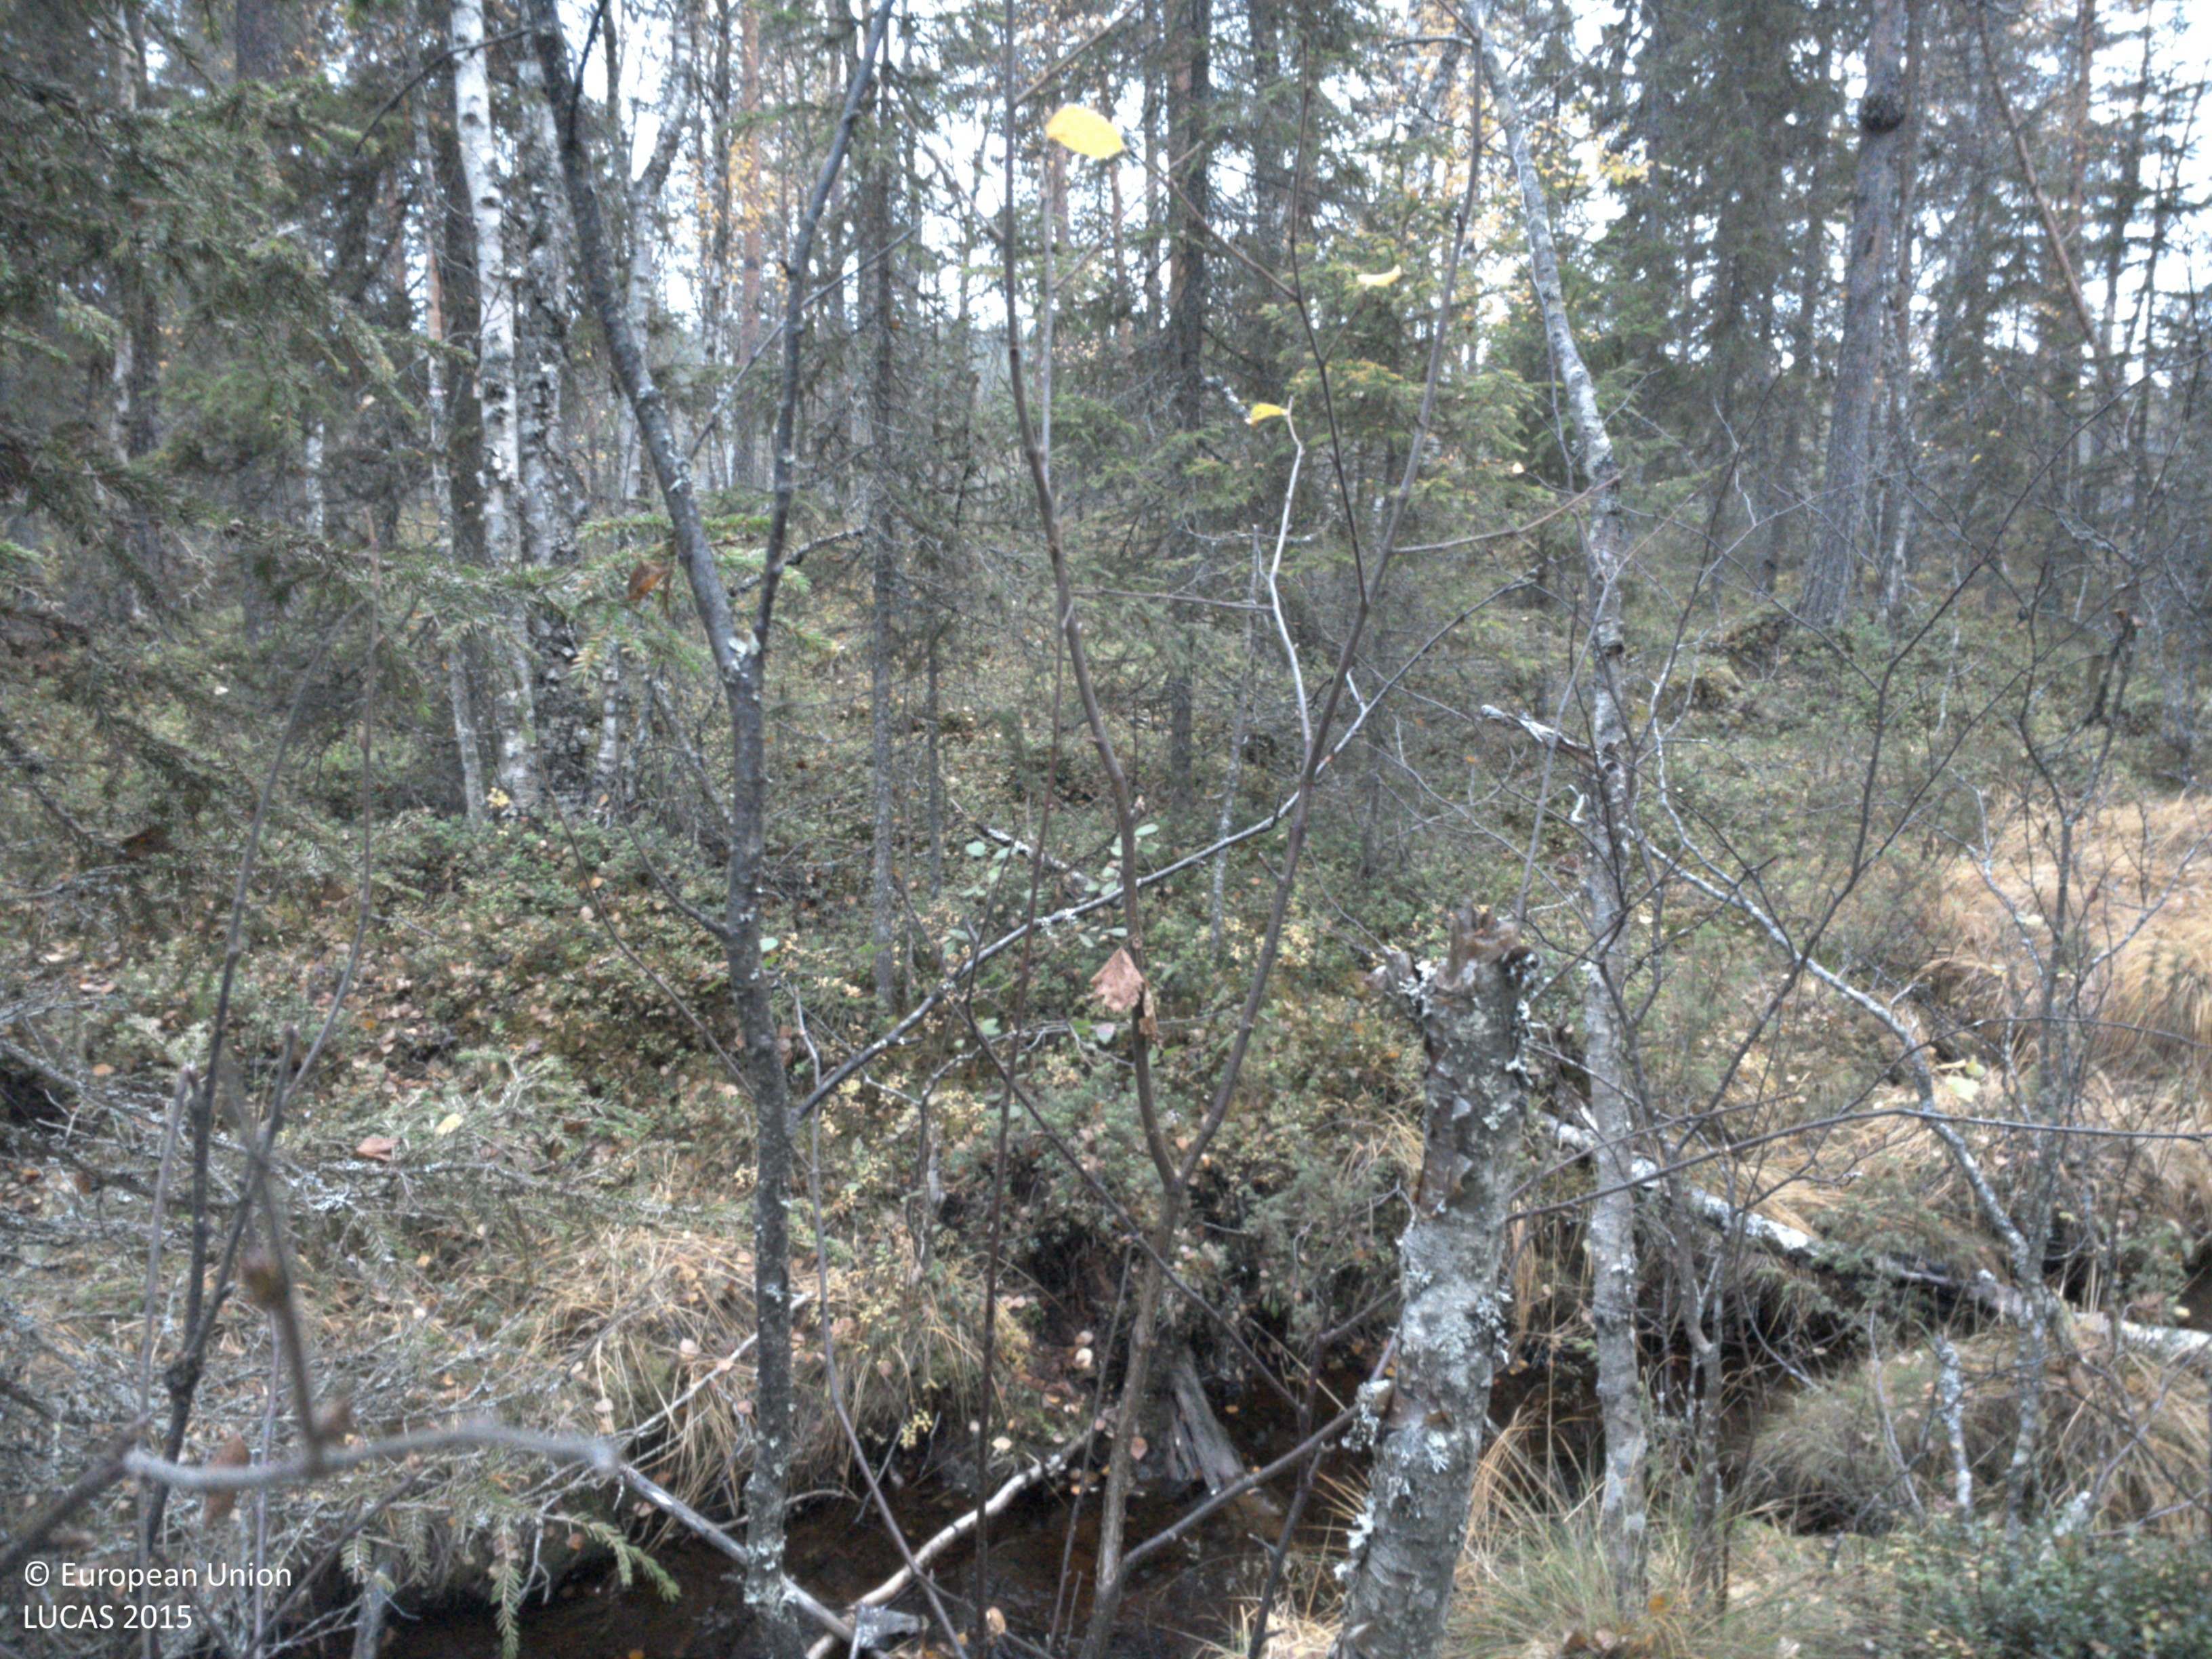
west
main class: Woodland
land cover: Pine dominated mixed woodland
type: boreal forest
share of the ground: > 75 %
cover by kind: coniferous forest trees 60 %, broadleaved forest trees 20 %, shrubs 10 %, herbaceous plants 5 %, lichens and mosses 5 %
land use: Forestry
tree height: > 5 m
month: September
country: SE
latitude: 64.8404
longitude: 18.8837
